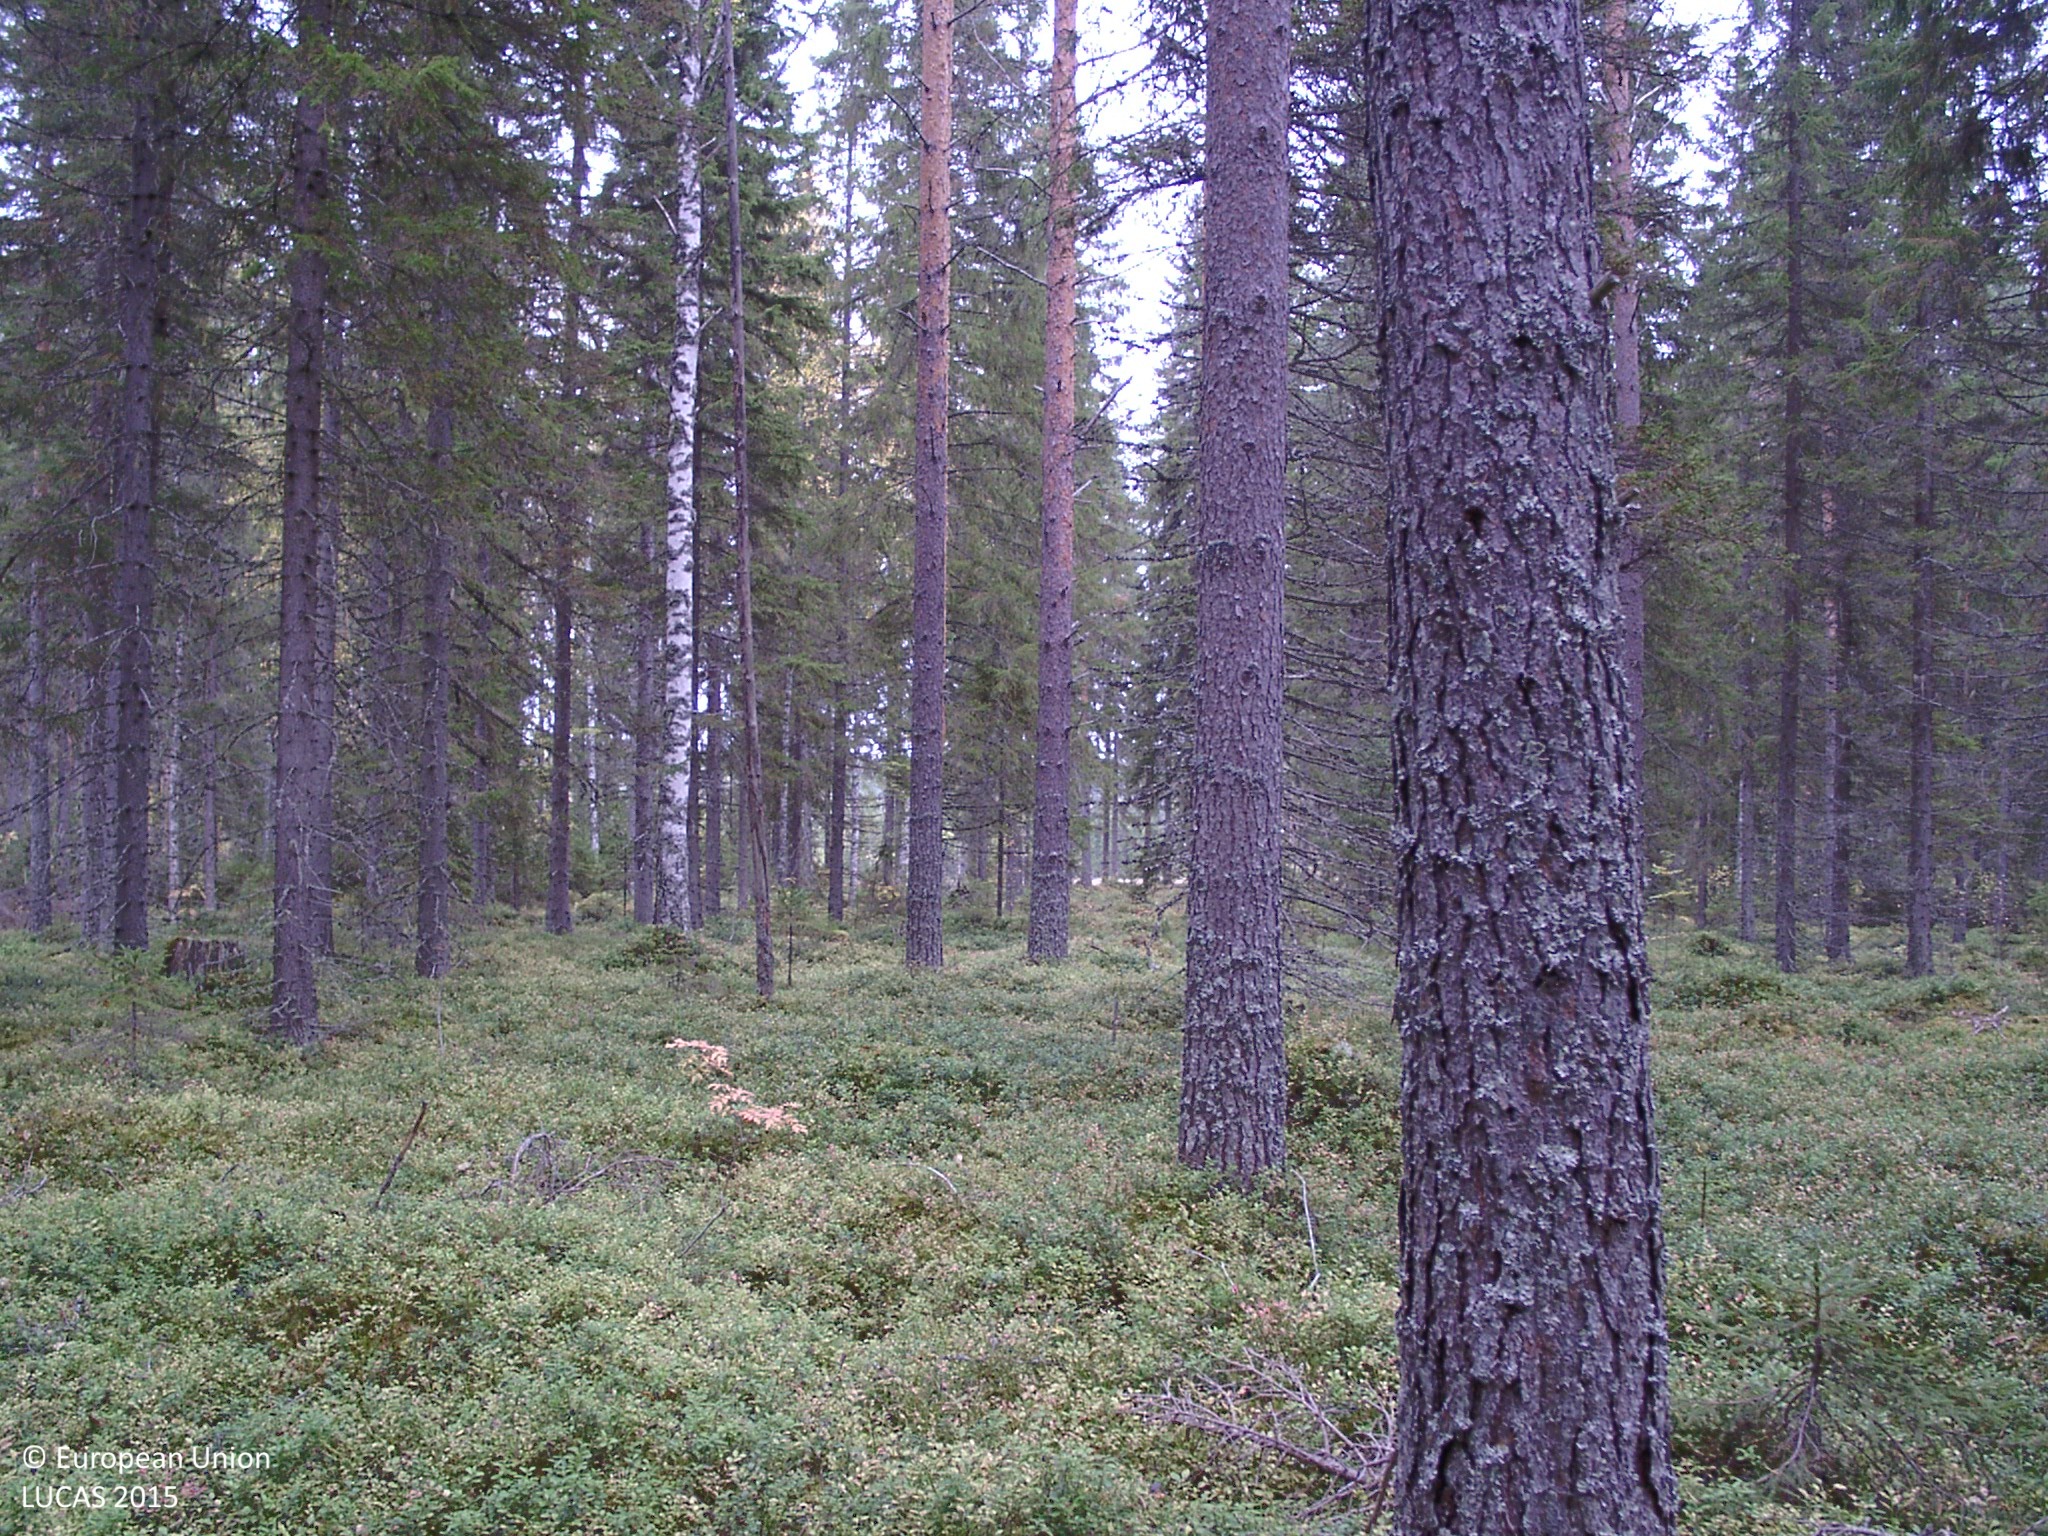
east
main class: Woodland
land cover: Other coniferous woodland
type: boreal forest
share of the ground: 50 - 75 %
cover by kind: coniferous forest trees 55 %, shrubs 25 %, lichens and mosses 15 %, broadleaved forest trees 5 %
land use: Forestry
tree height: > 5 m
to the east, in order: Other coniferous woodland; Spruce dominated coniferous woodland; Spruce dominated mixed woodland; Spruce dominated coniferous woodland; Ditches and canals; Spruce dominated coniferous woodland; Tracks; Spruce dominated coniferous woodland; Shrubland without tree cover; Grassland with sparse tree/shrub cover; Shrubland with sparse tree cover; Tracks; Shrubland without tree cover
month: September
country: FI
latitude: 62.5864
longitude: 25.2320
